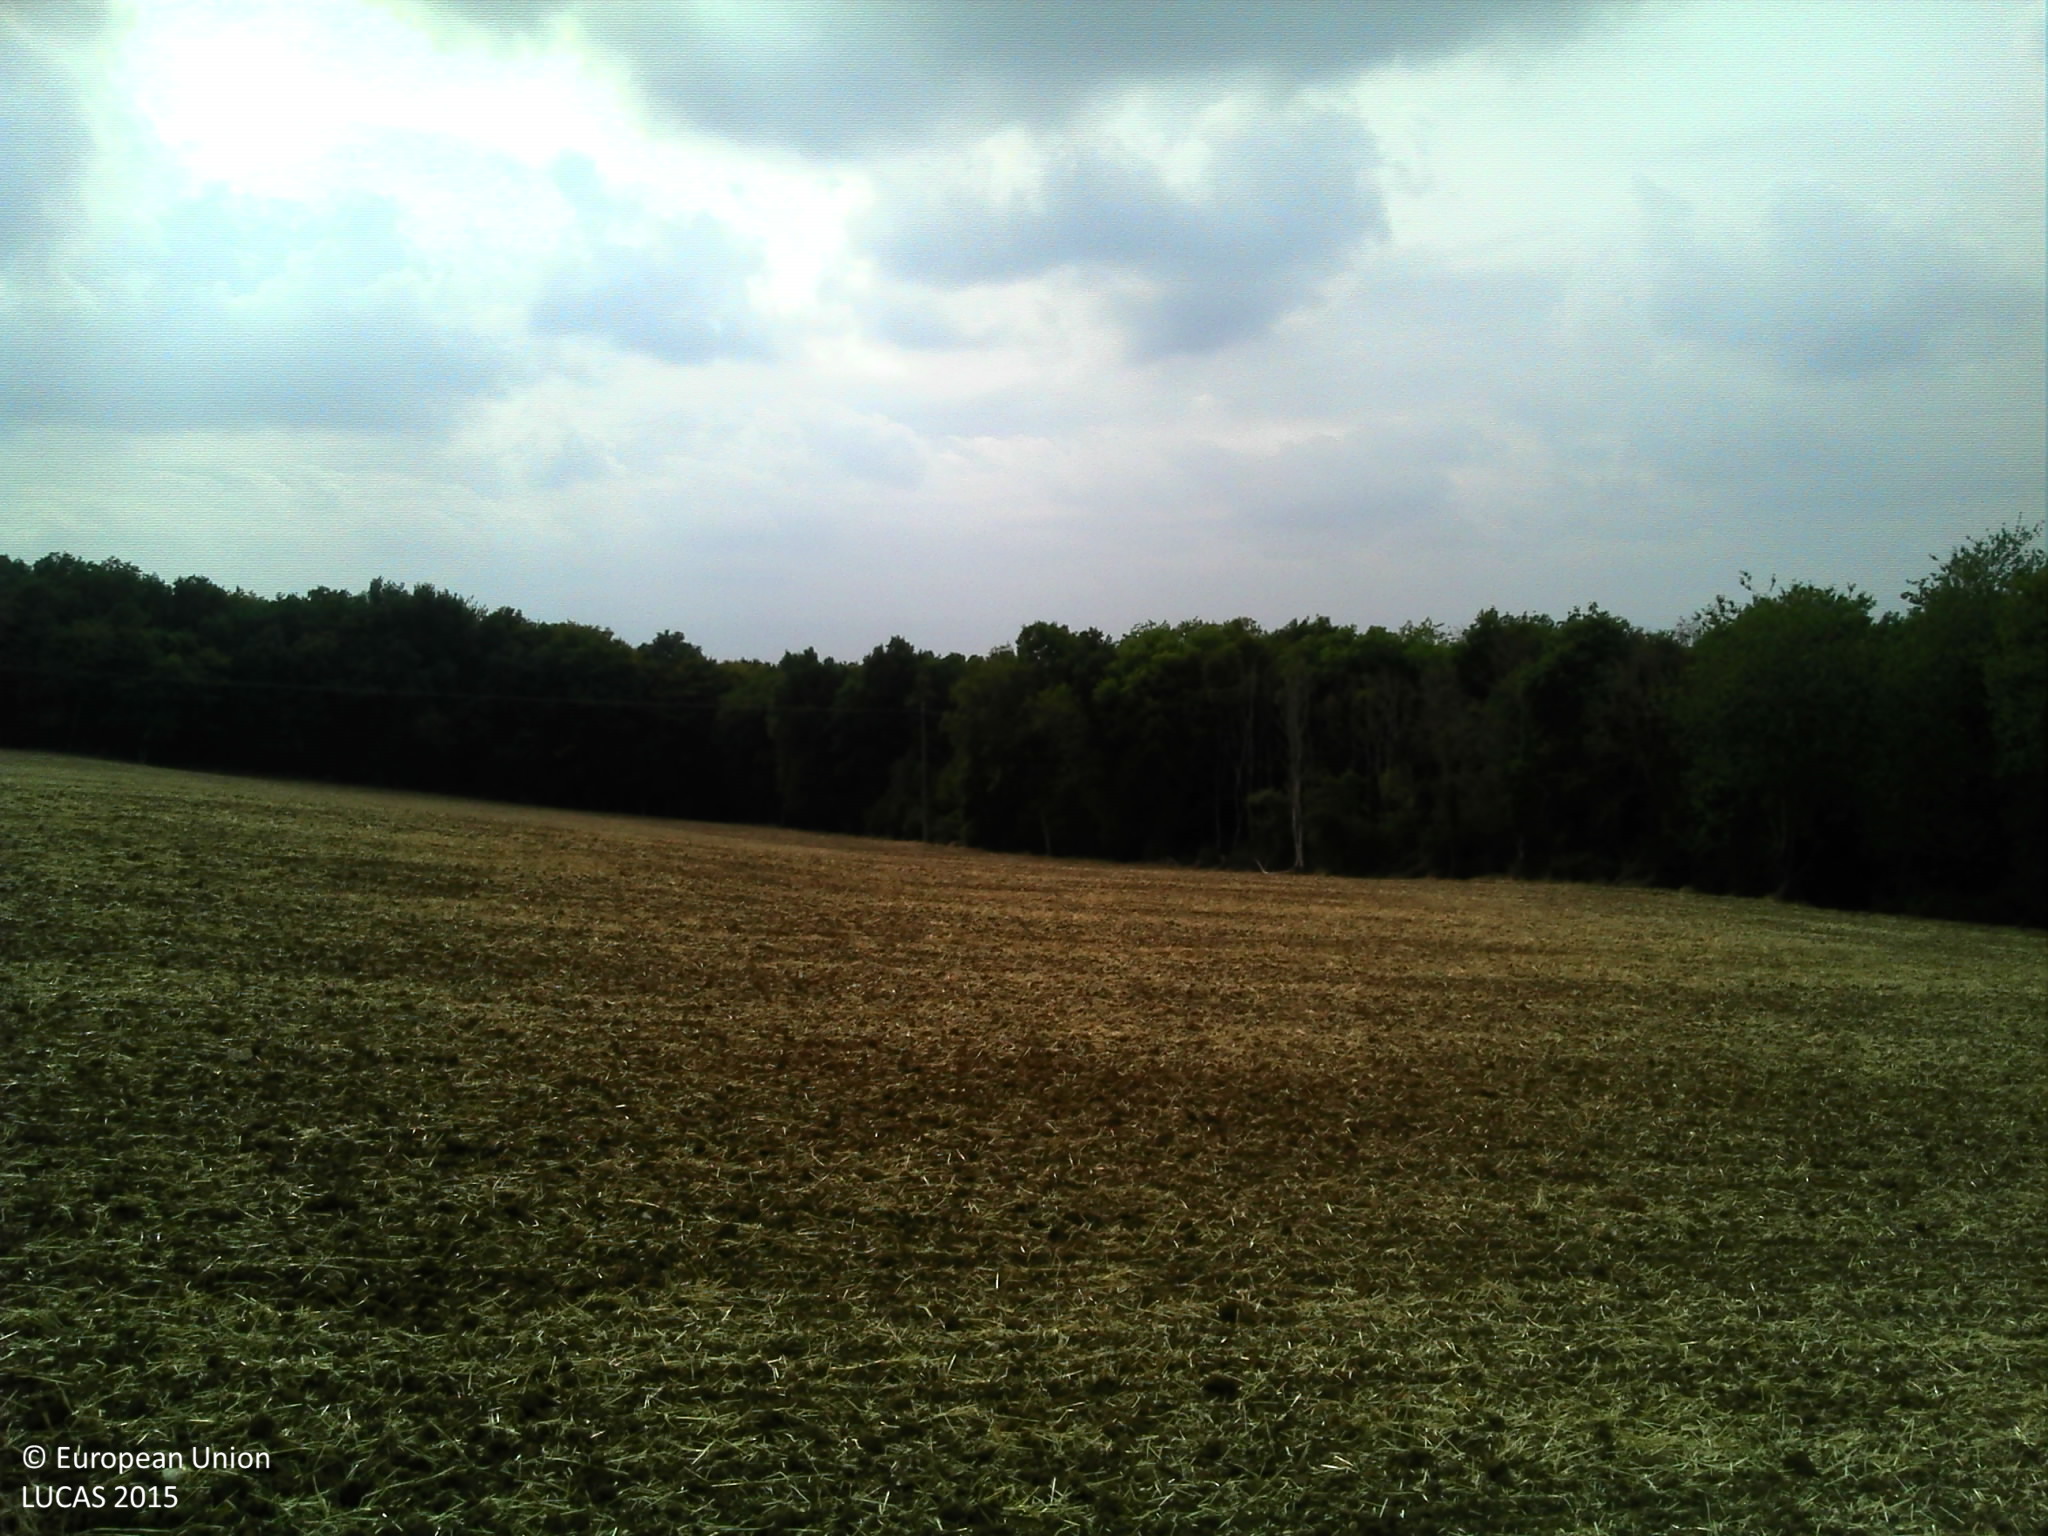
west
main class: Woodland
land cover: Broadleaved woodland
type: mesophytic deciduous forest
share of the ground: > 75 %
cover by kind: broadleaved forest trees 60 %, shrubs 40 %
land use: Forestry
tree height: > 5 m
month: August
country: FR
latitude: 48.2187
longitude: 2.7365
